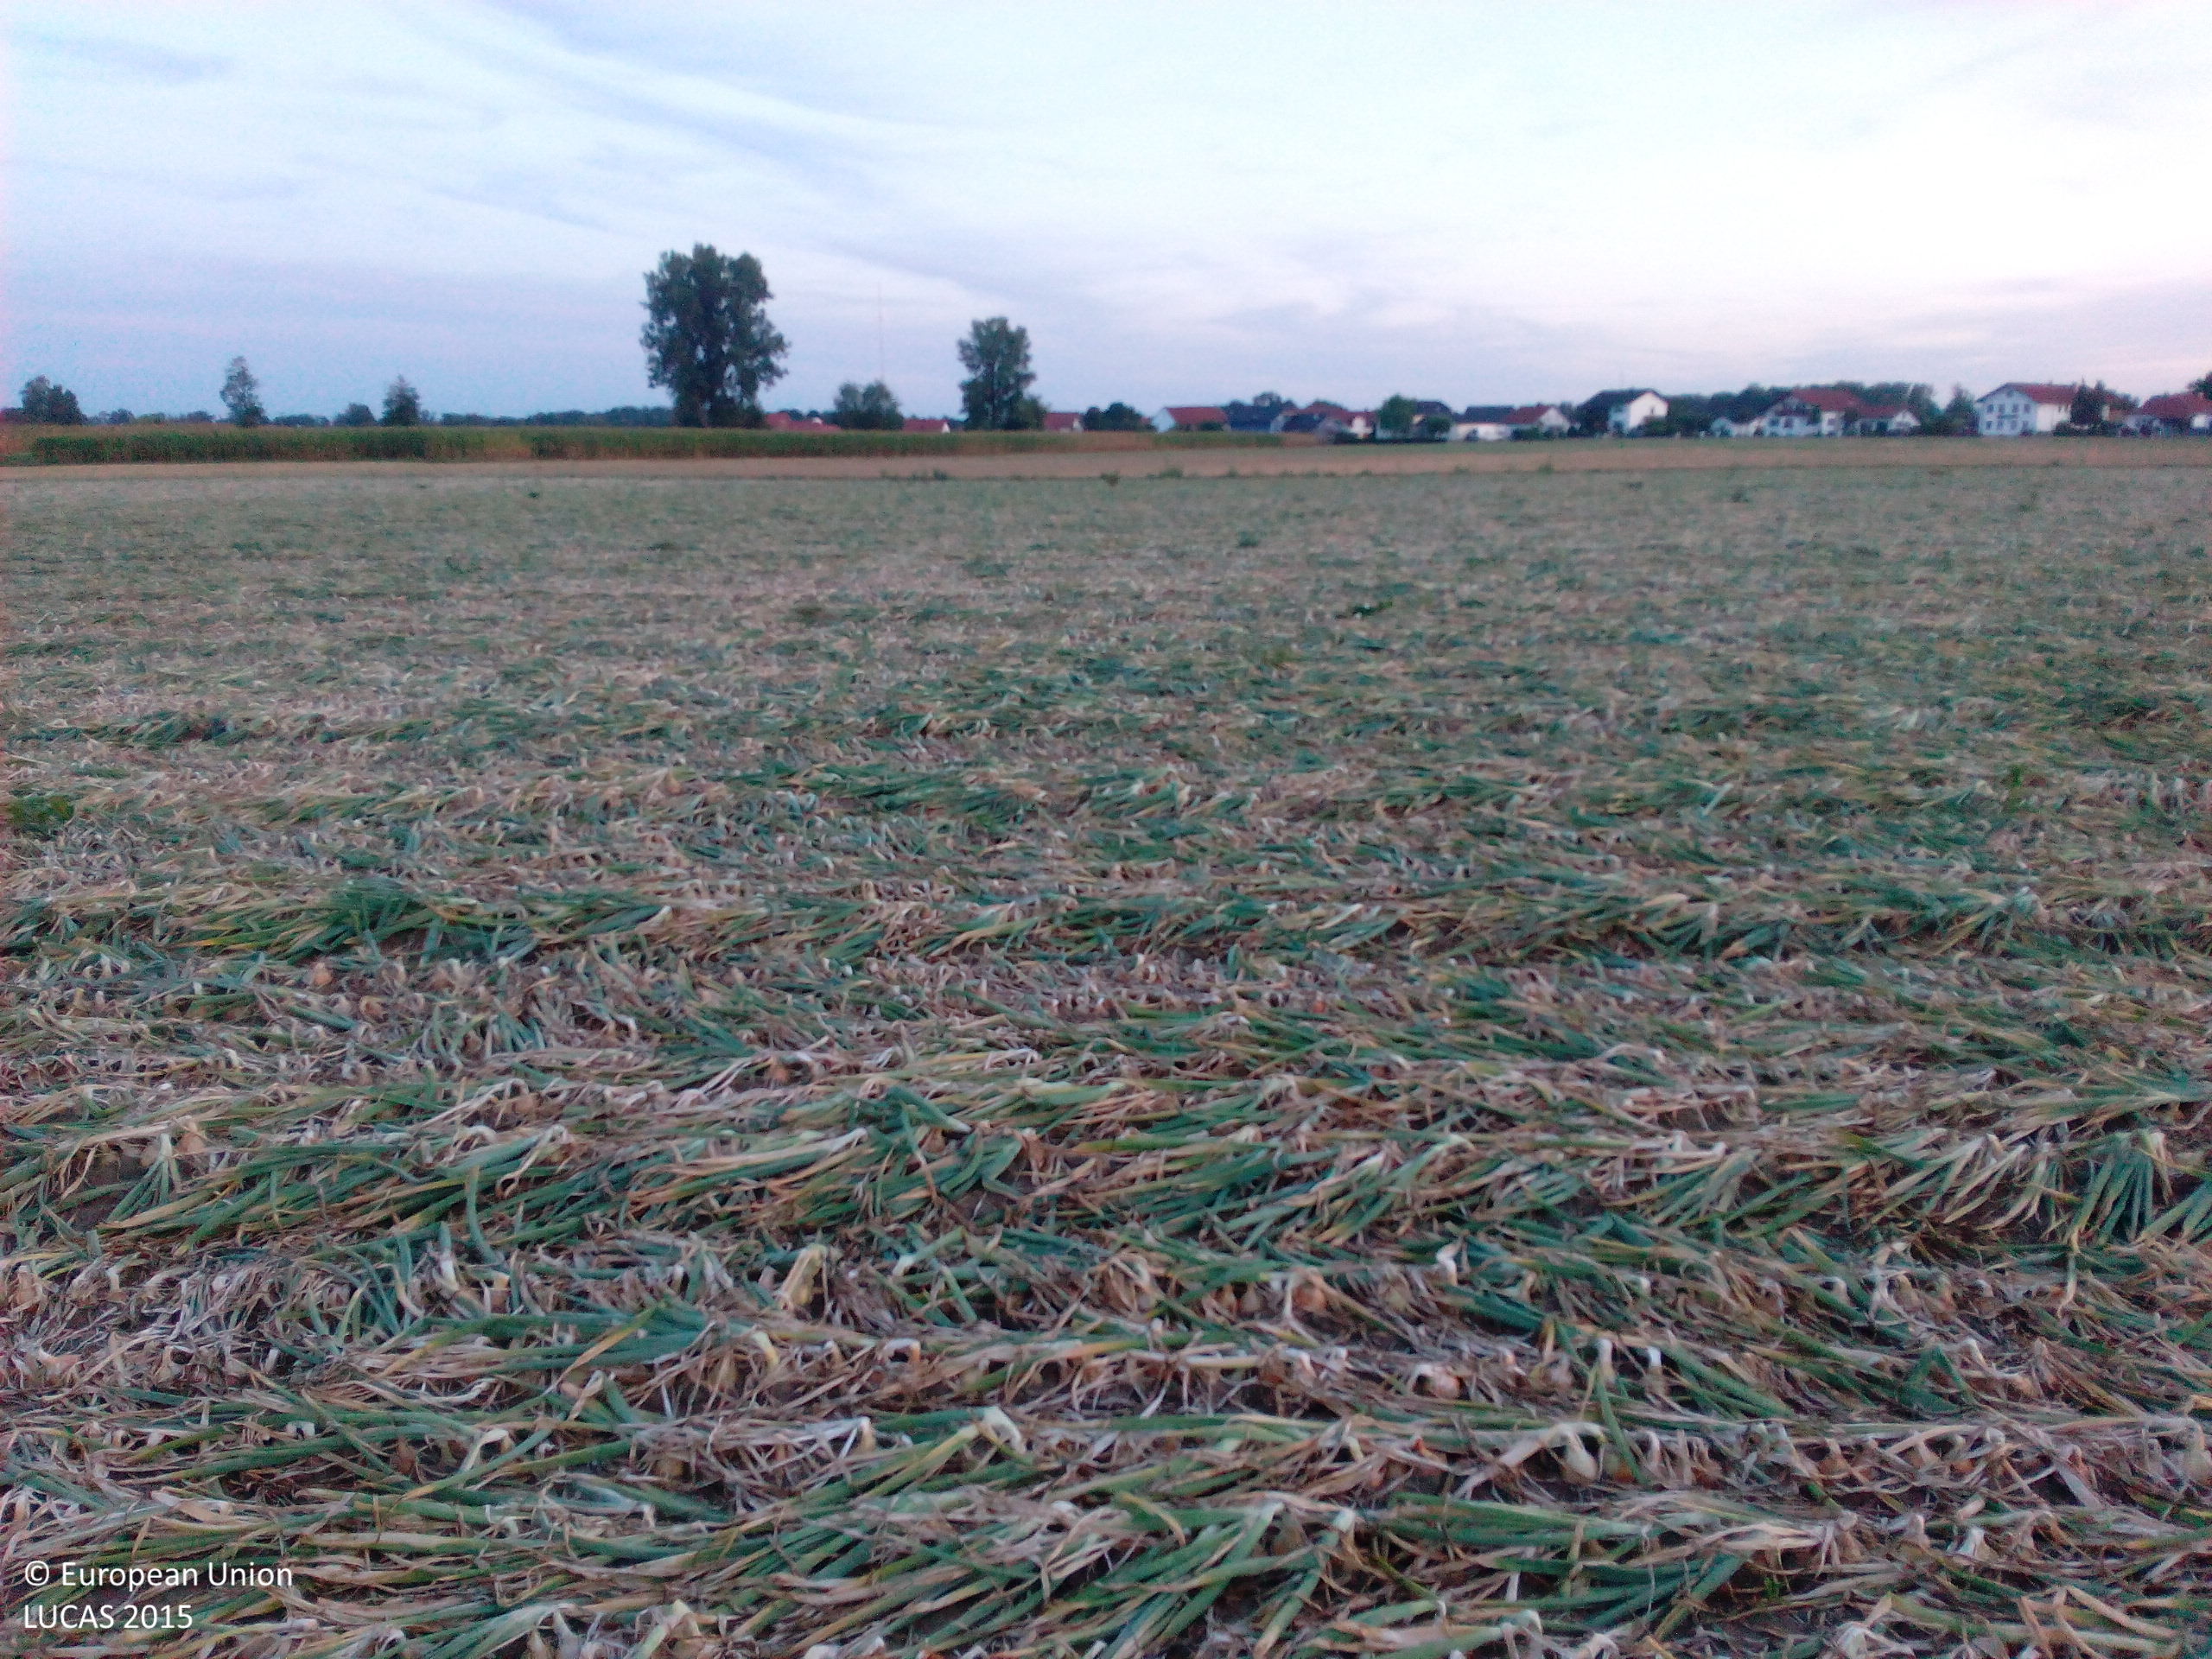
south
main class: Cropland
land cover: Other root crops
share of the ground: 50 - 75 %
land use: Agriculture (excluding fallow land and kitchen gardens)
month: August
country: DE
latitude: 48.7609
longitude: 12.9242
